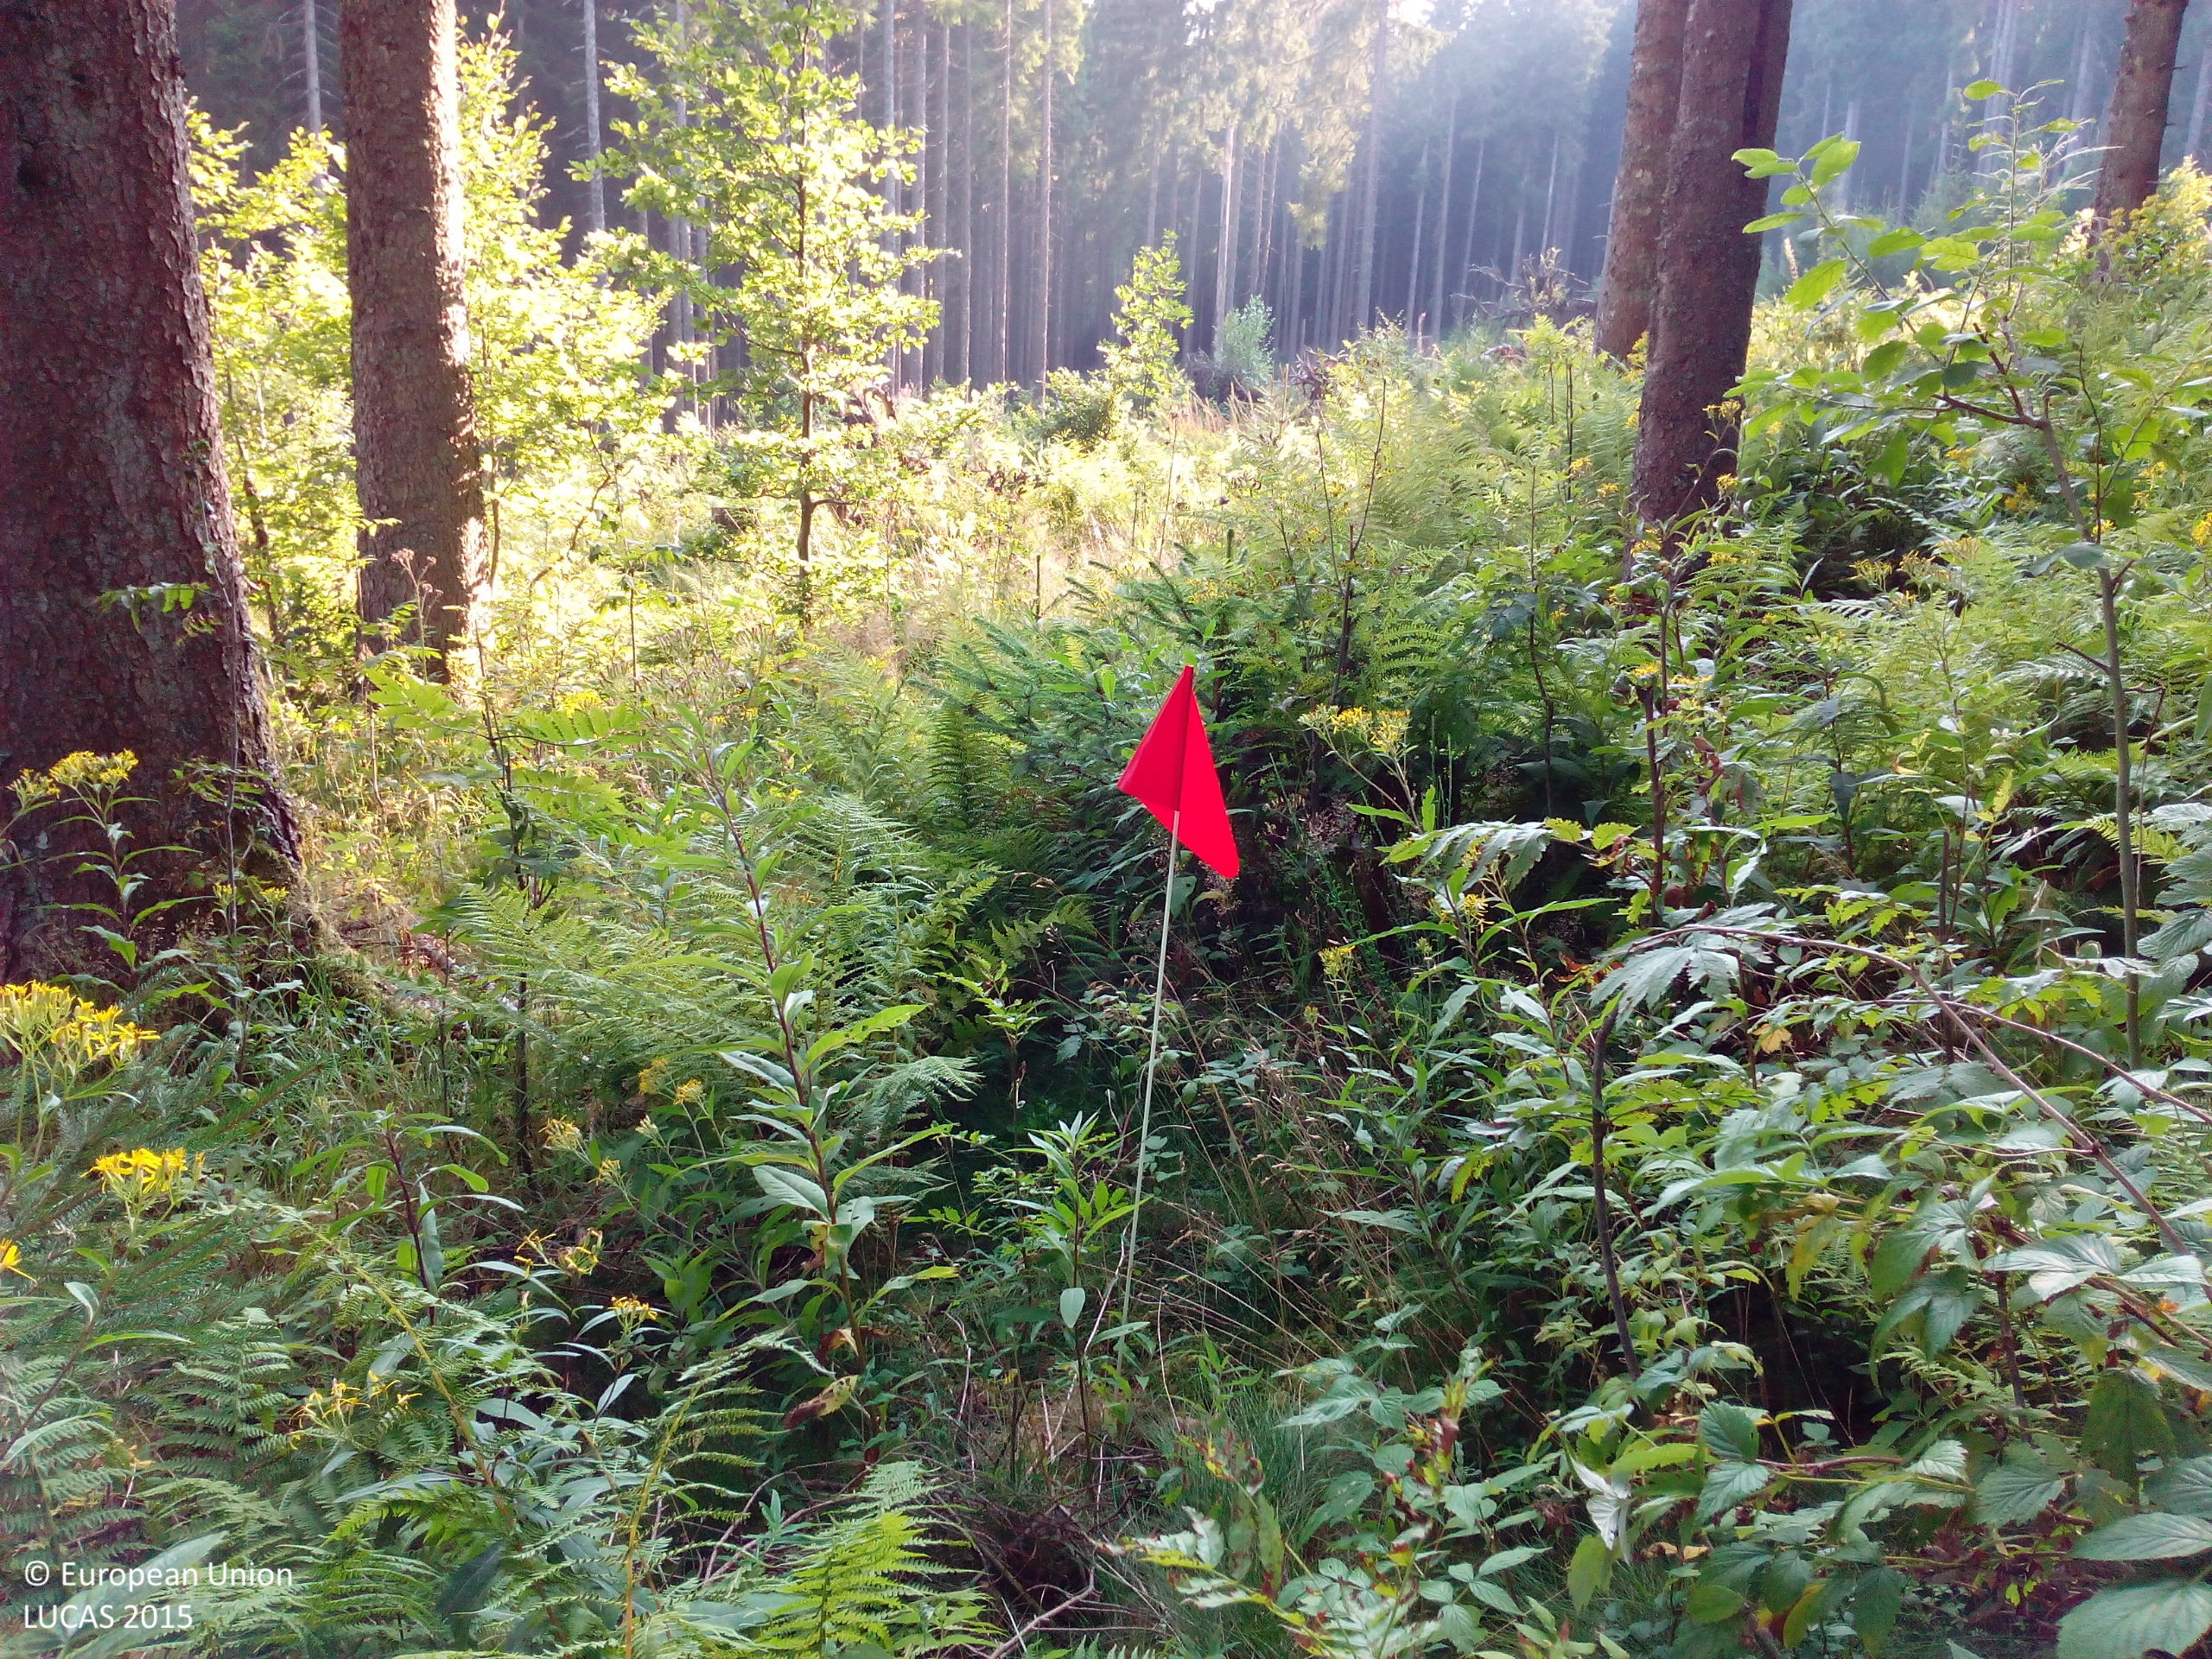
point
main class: Woodland
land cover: Spruce dominated coniferous woodland
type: hemiboreal forest and nemoral coniferous forest and mixed broadleaved-coniferous forest
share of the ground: 50 - 75 %
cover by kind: coniferous forest trees 60 %, shrubs 20 %, herbaceous plants 20 %
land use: Forestry
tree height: > 5 m
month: August
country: DE
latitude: 47.8475
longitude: 8.1170
